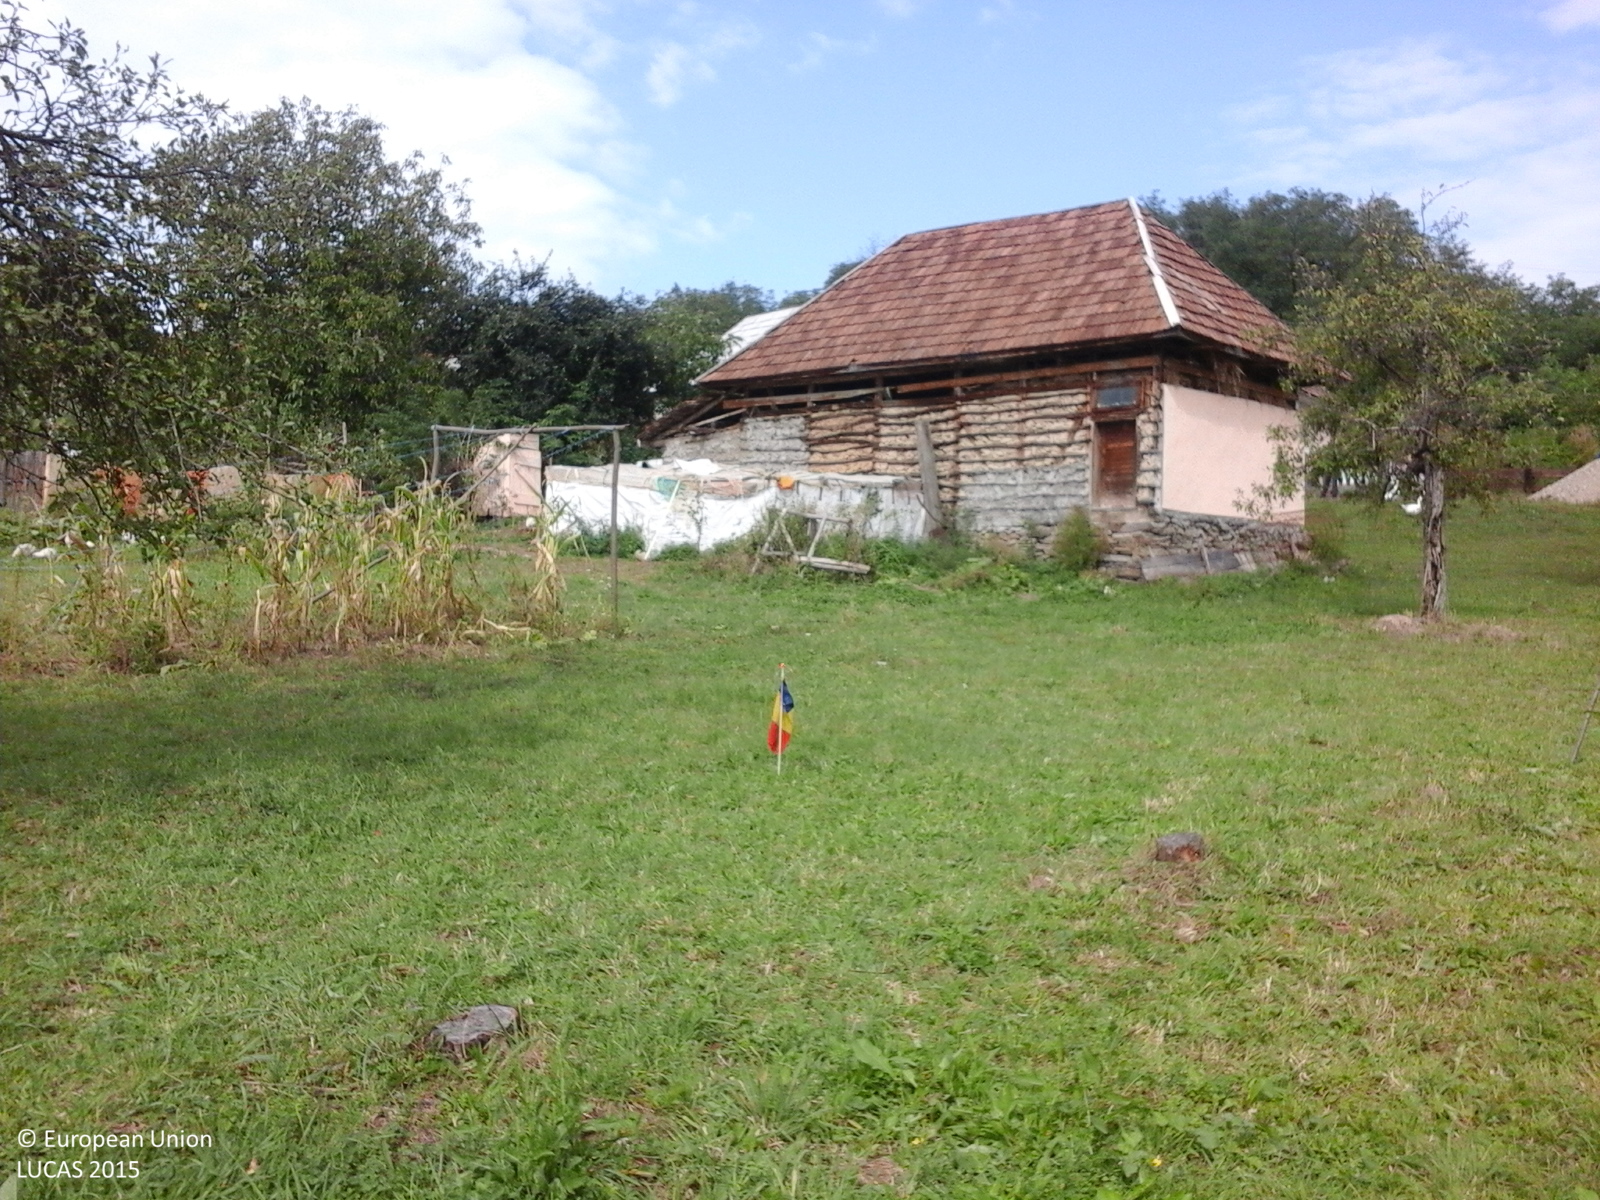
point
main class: Cropland
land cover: Apple fruit
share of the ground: 50 - 75 %
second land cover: Grassland without tree/shrub cover
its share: > 75 %
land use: Agriculture (excluding fallow land and kitchen gardens)
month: September
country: RO
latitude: 47.5306
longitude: 23.5301
